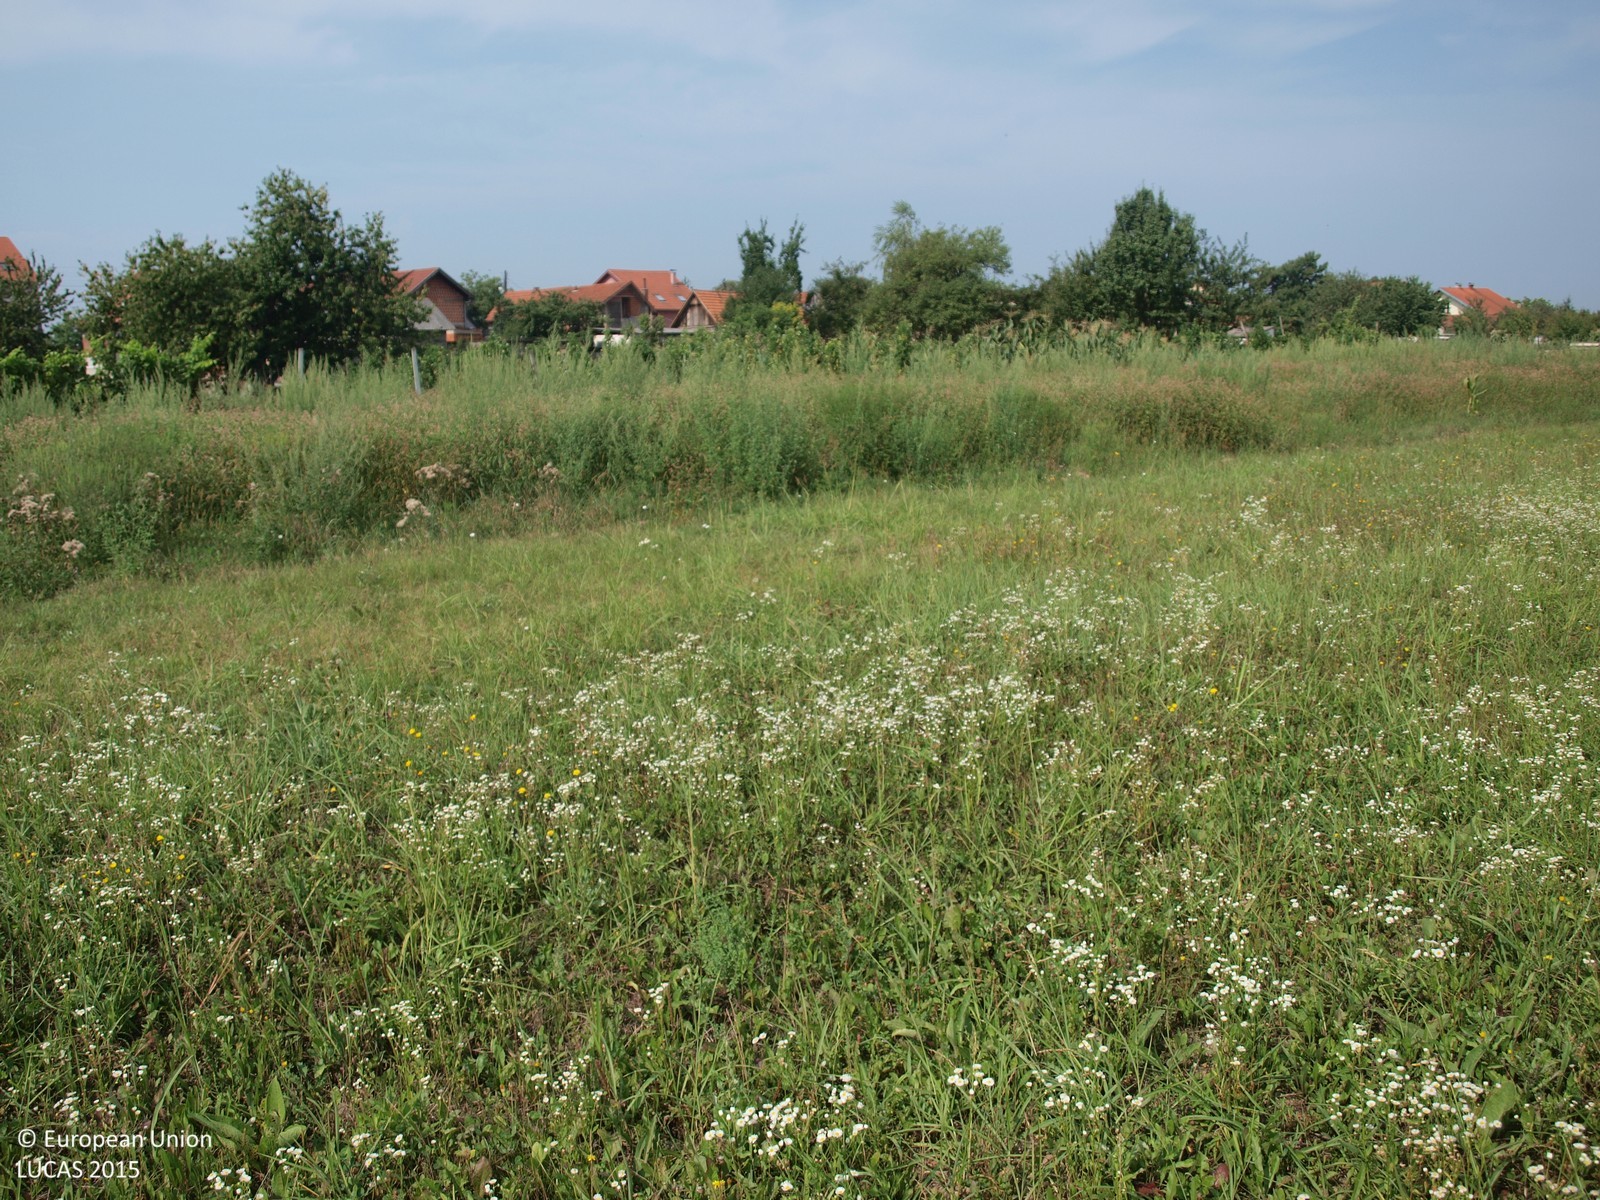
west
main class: Grassland
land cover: Grassland without tree/shrub cover
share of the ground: > 75 %
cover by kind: herbaceous plants 100 %
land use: Agriculture (excluding fallow land and kitchen gardens)
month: August
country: HR
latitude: 45.7758
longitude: 15.8491
